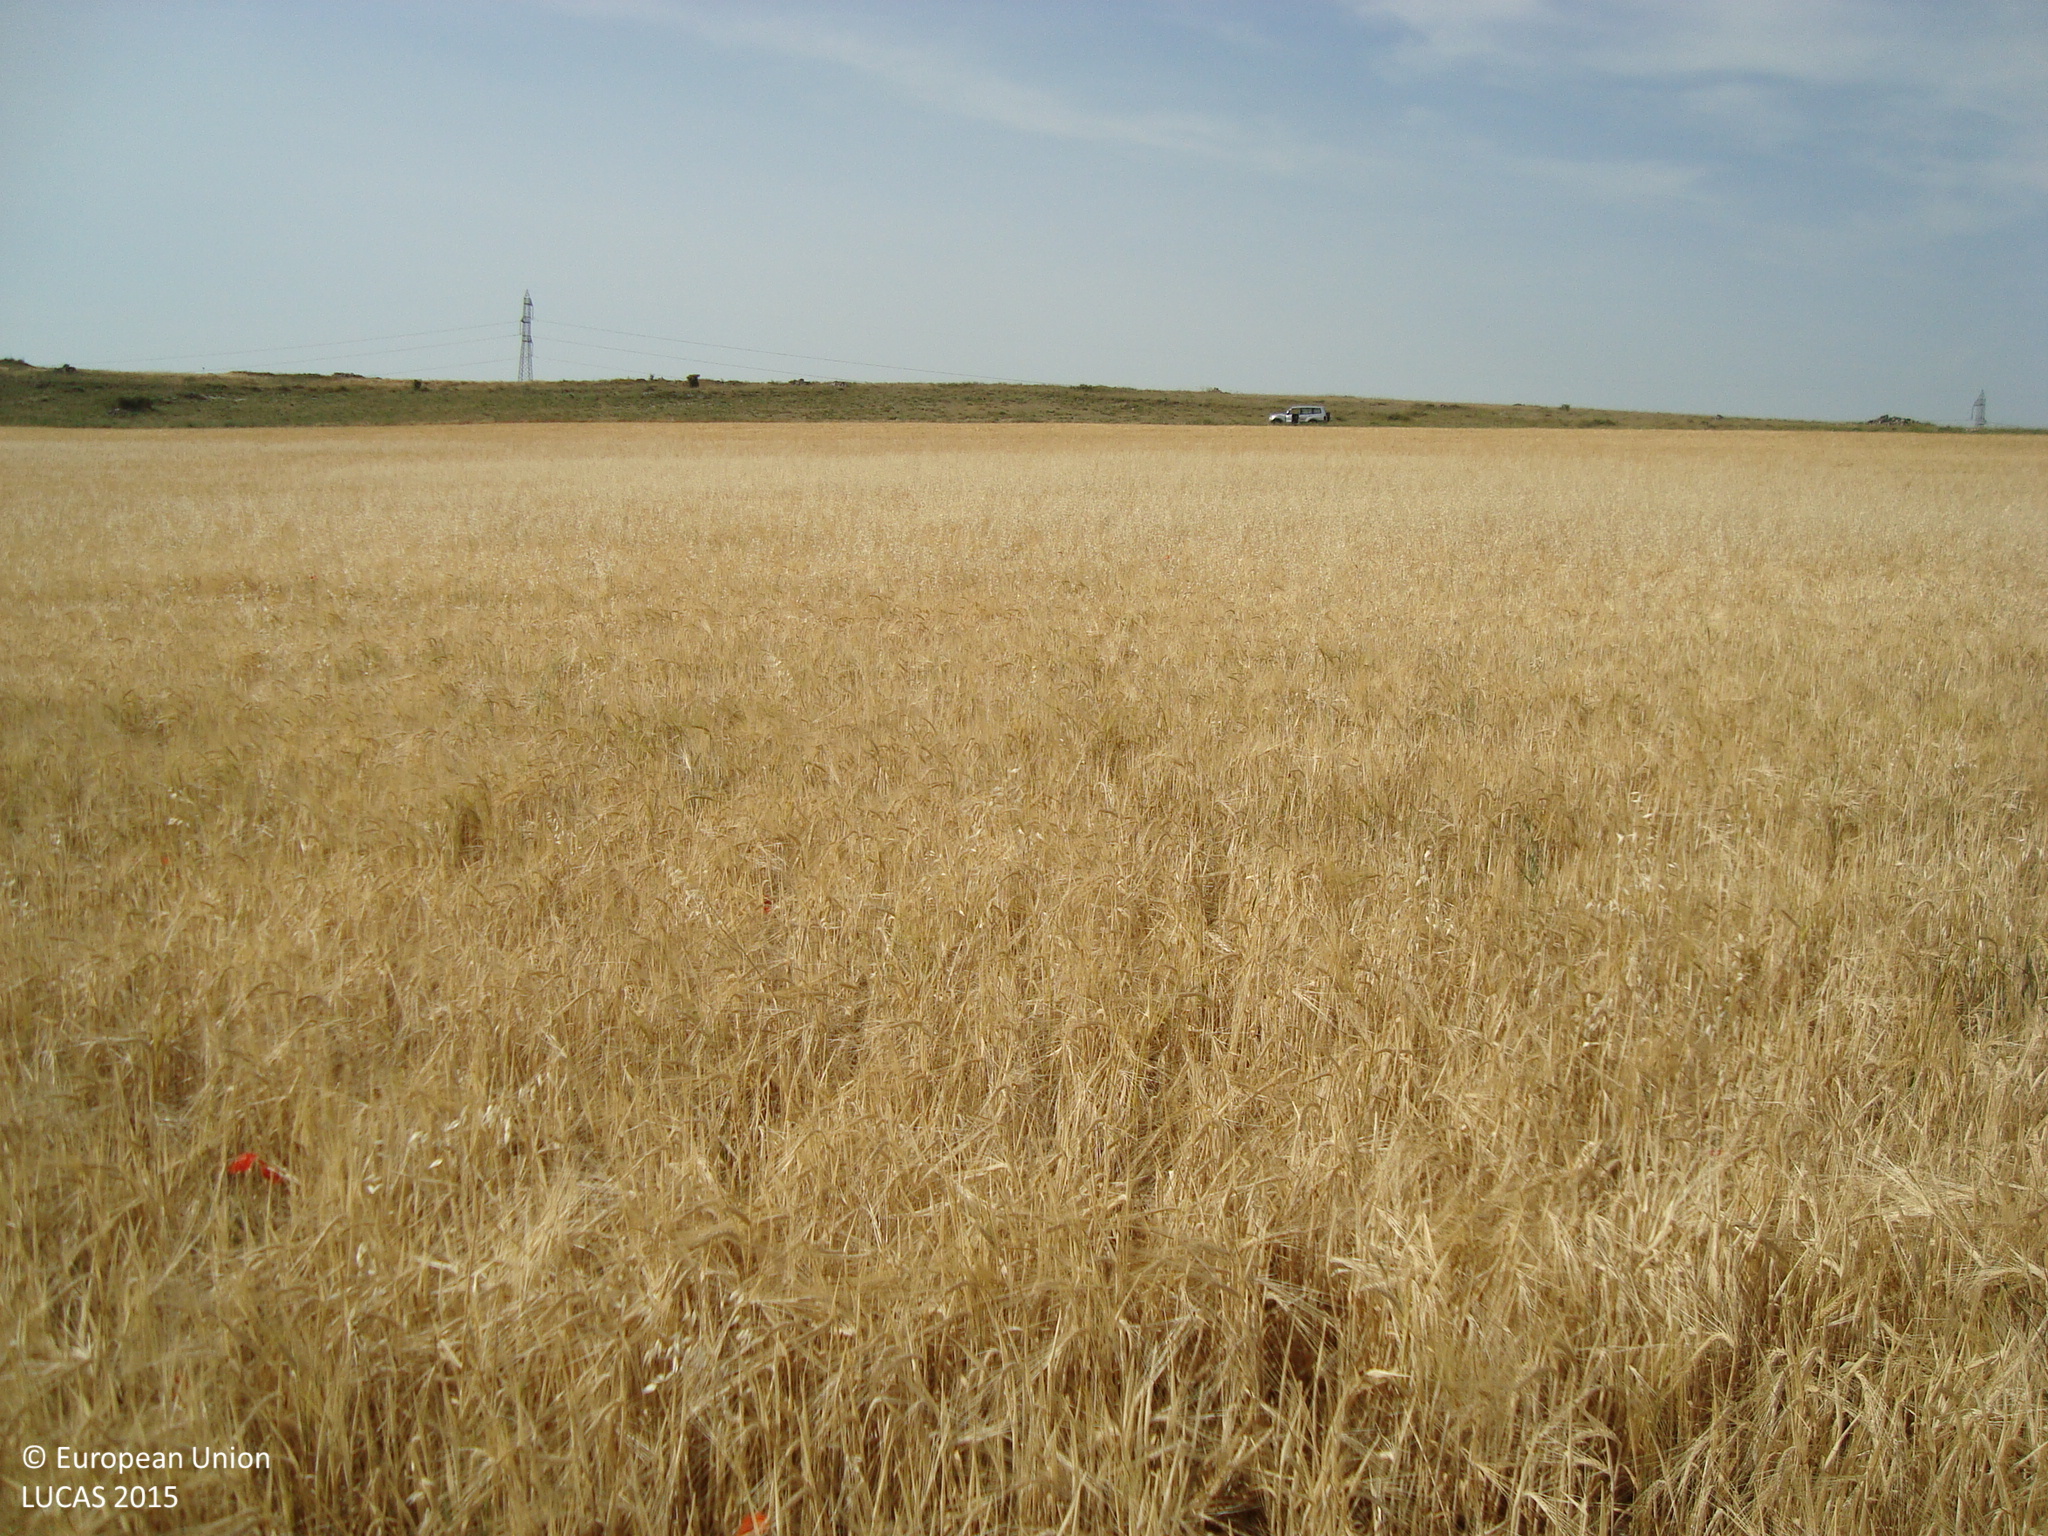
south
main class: Cropland
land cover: Barley
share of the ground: > 75 %
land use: Agriculture (excluding fallow land and kitchen gardens)
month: July
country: ES
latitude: 41.7054
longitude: -4.1813
